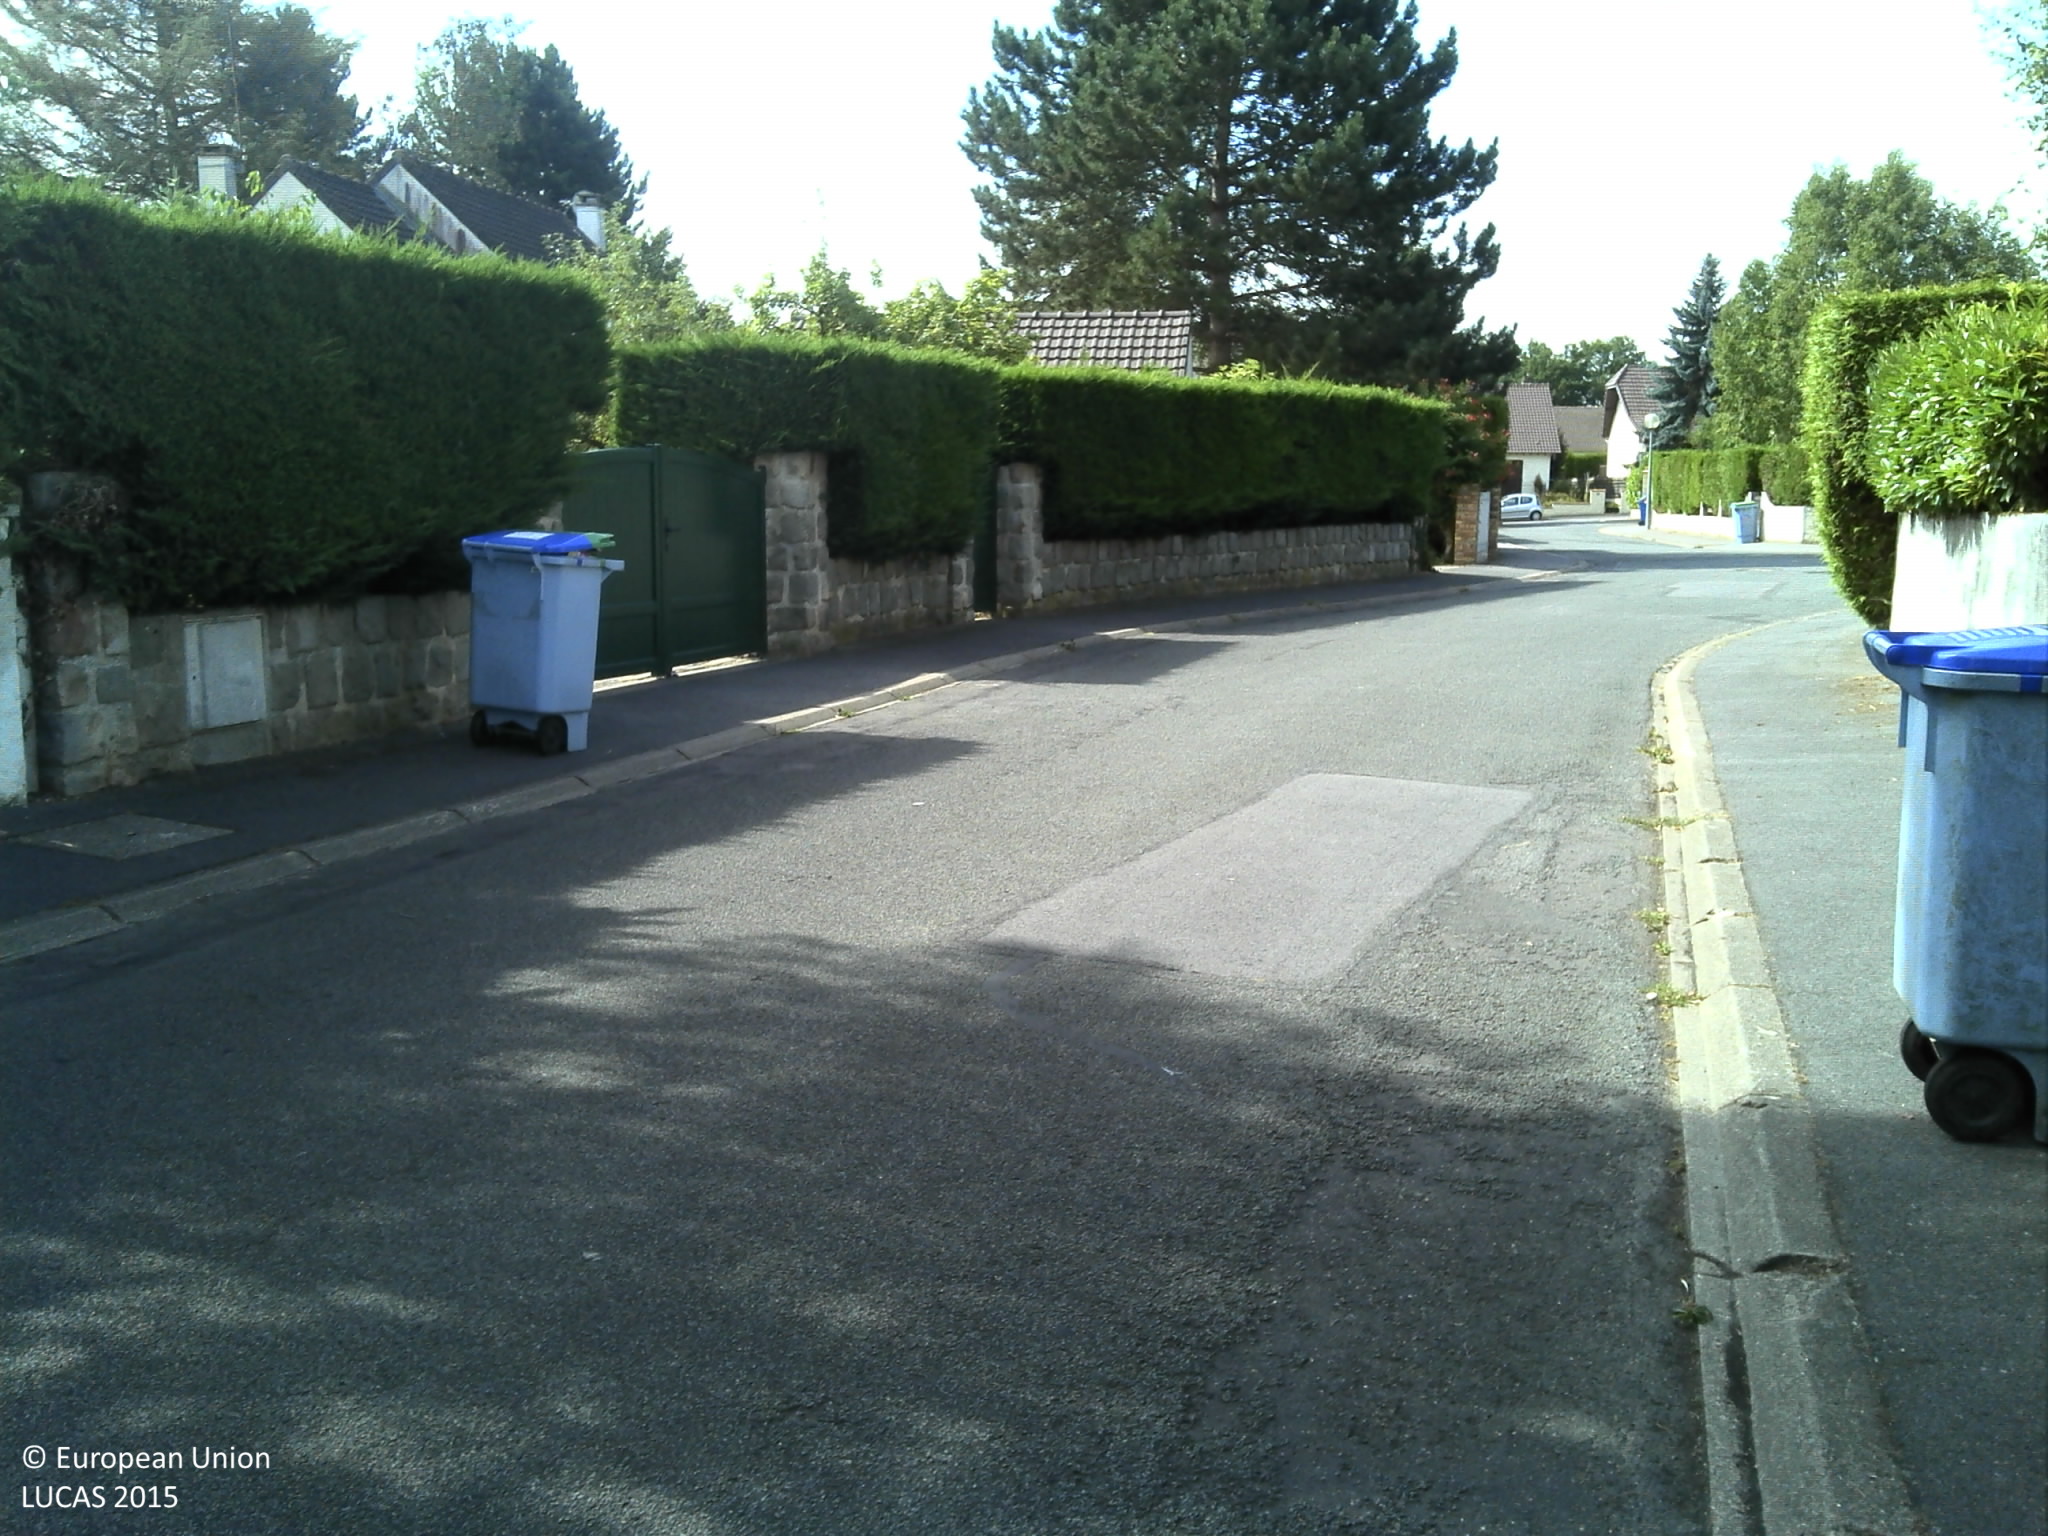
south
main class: Grassland
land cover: Grassland with sparse tree/shrub cover
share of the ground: > 75 %
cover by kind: herbaceous plants 95 %, broadleaved forest trees 5 %
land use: Residential
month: July
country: FR
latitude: 48.5796
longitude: 1.9479
